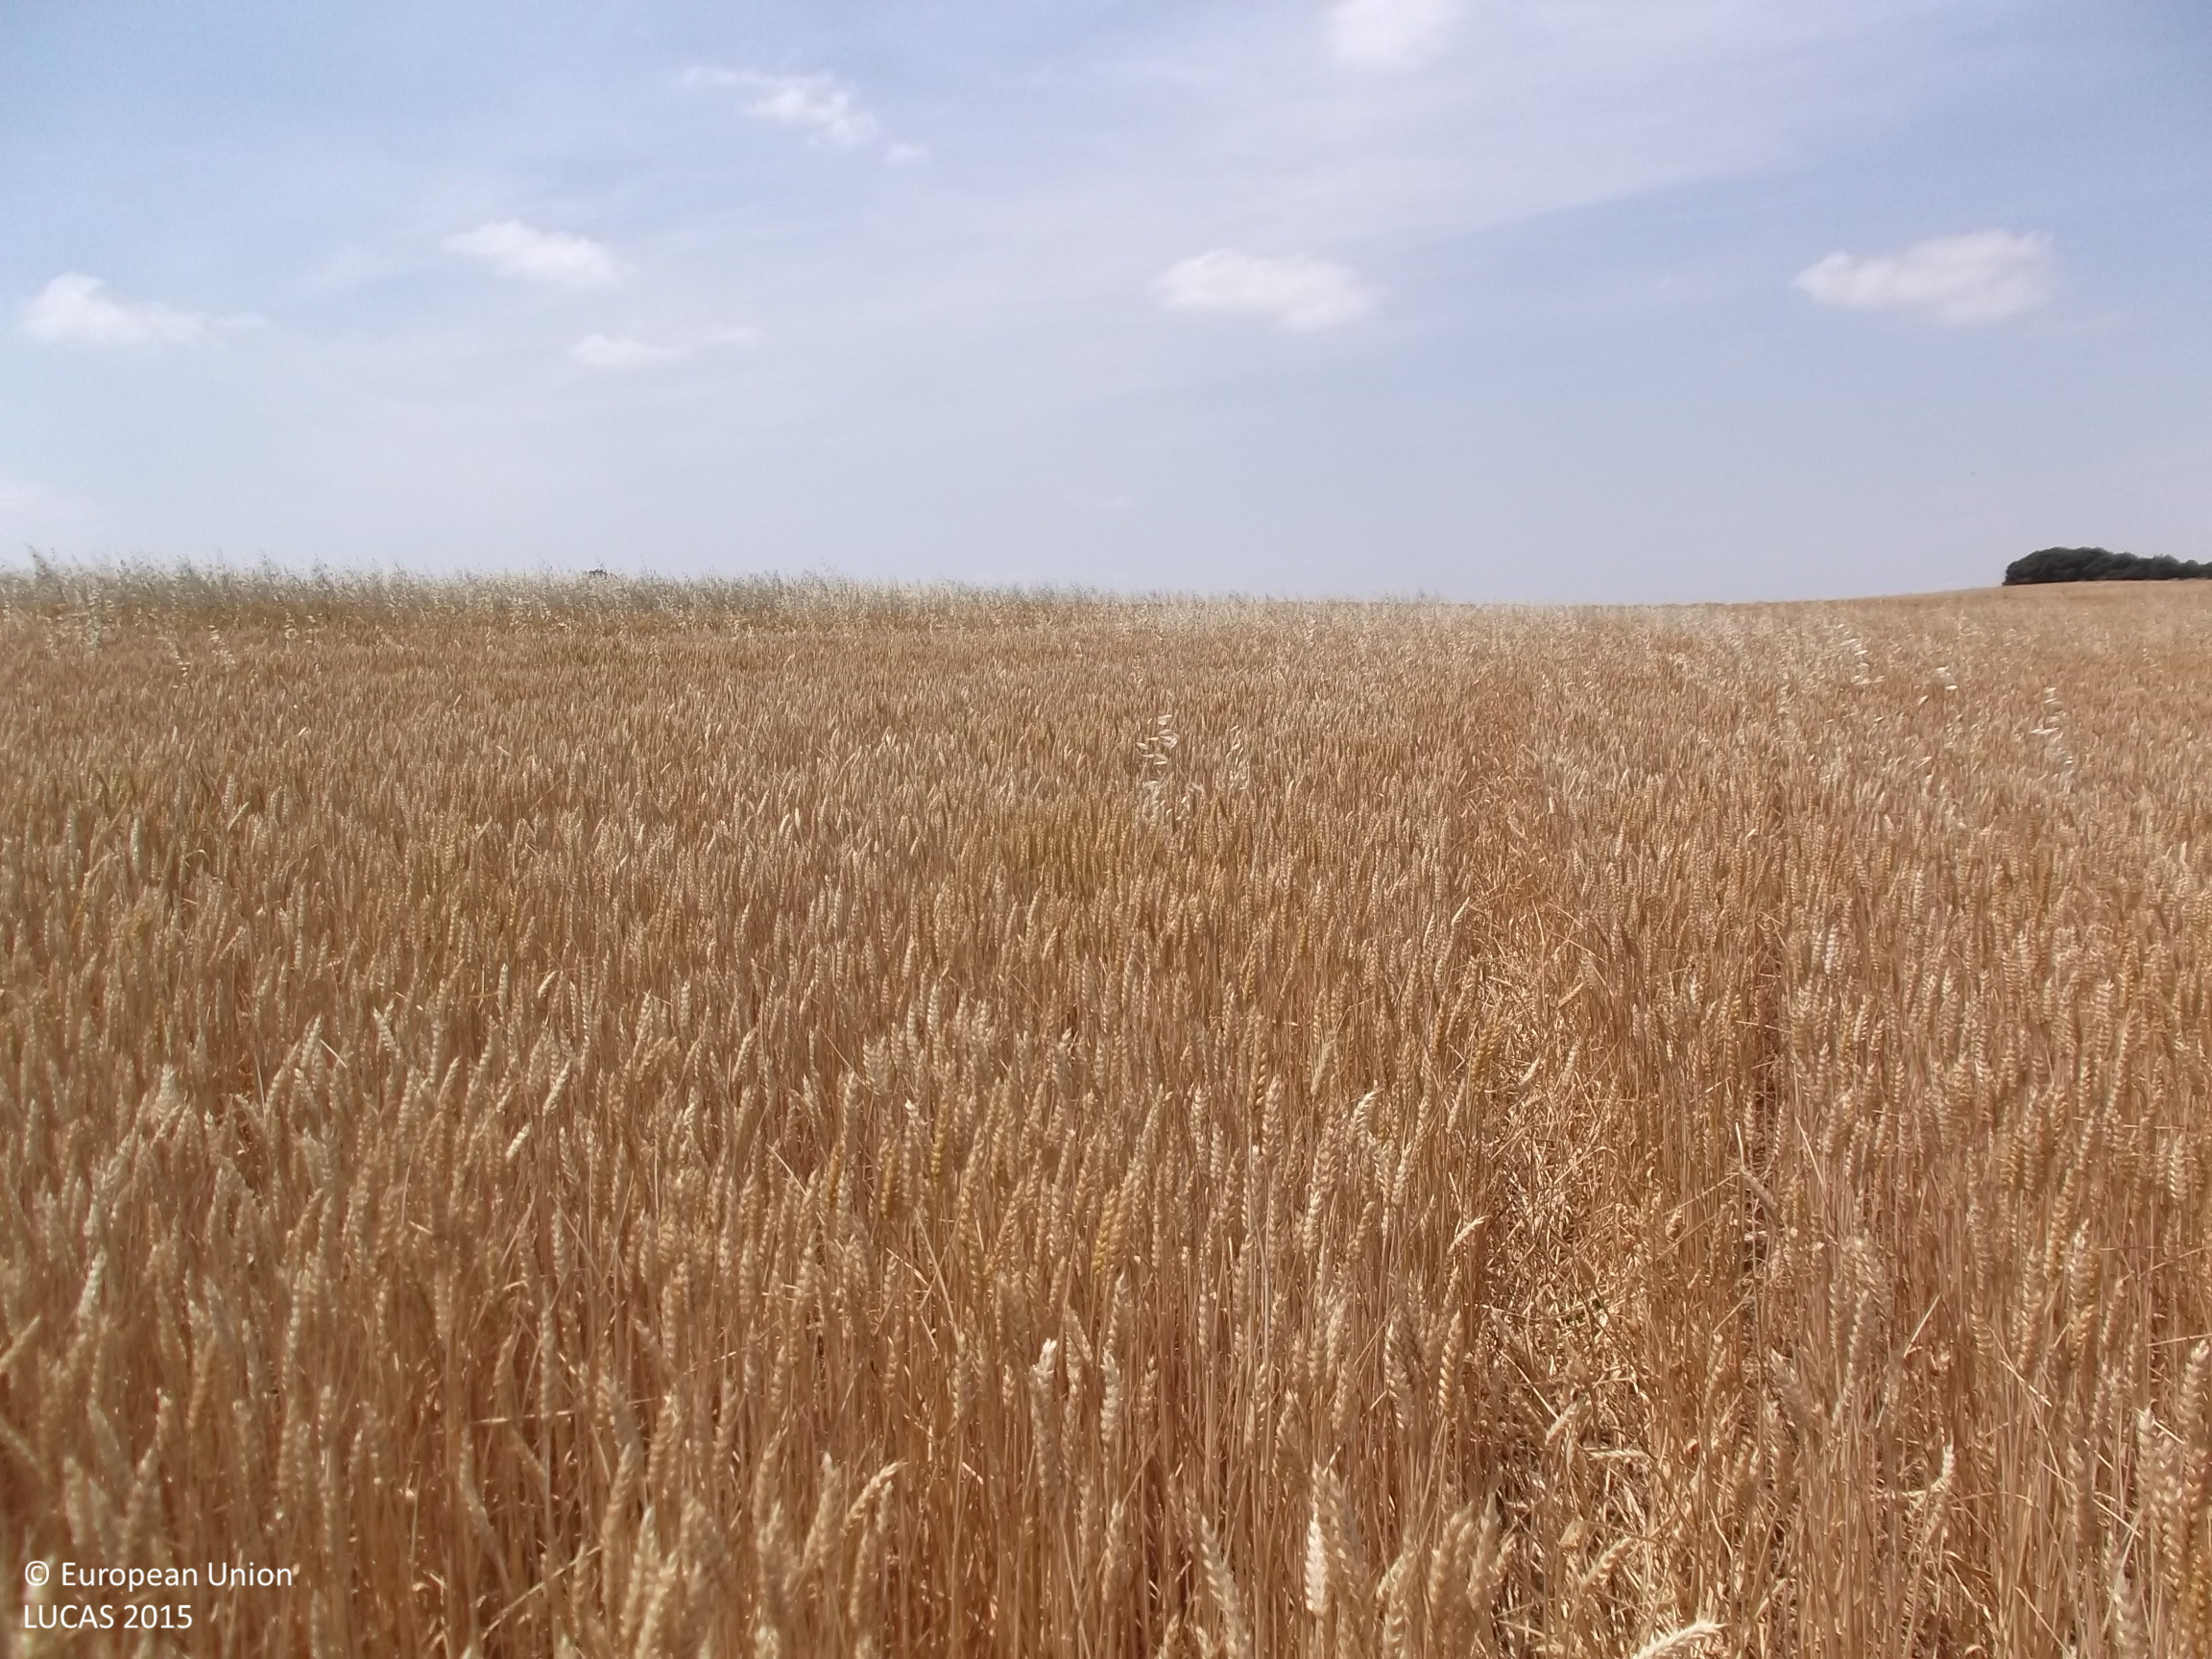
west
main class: Cropland
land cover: Common wheat
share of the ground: > 75 %
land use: Agriculture (excluding fallow land and kitchen gardens)
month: June
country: ES
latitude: 42.4976
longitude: -2.1981
